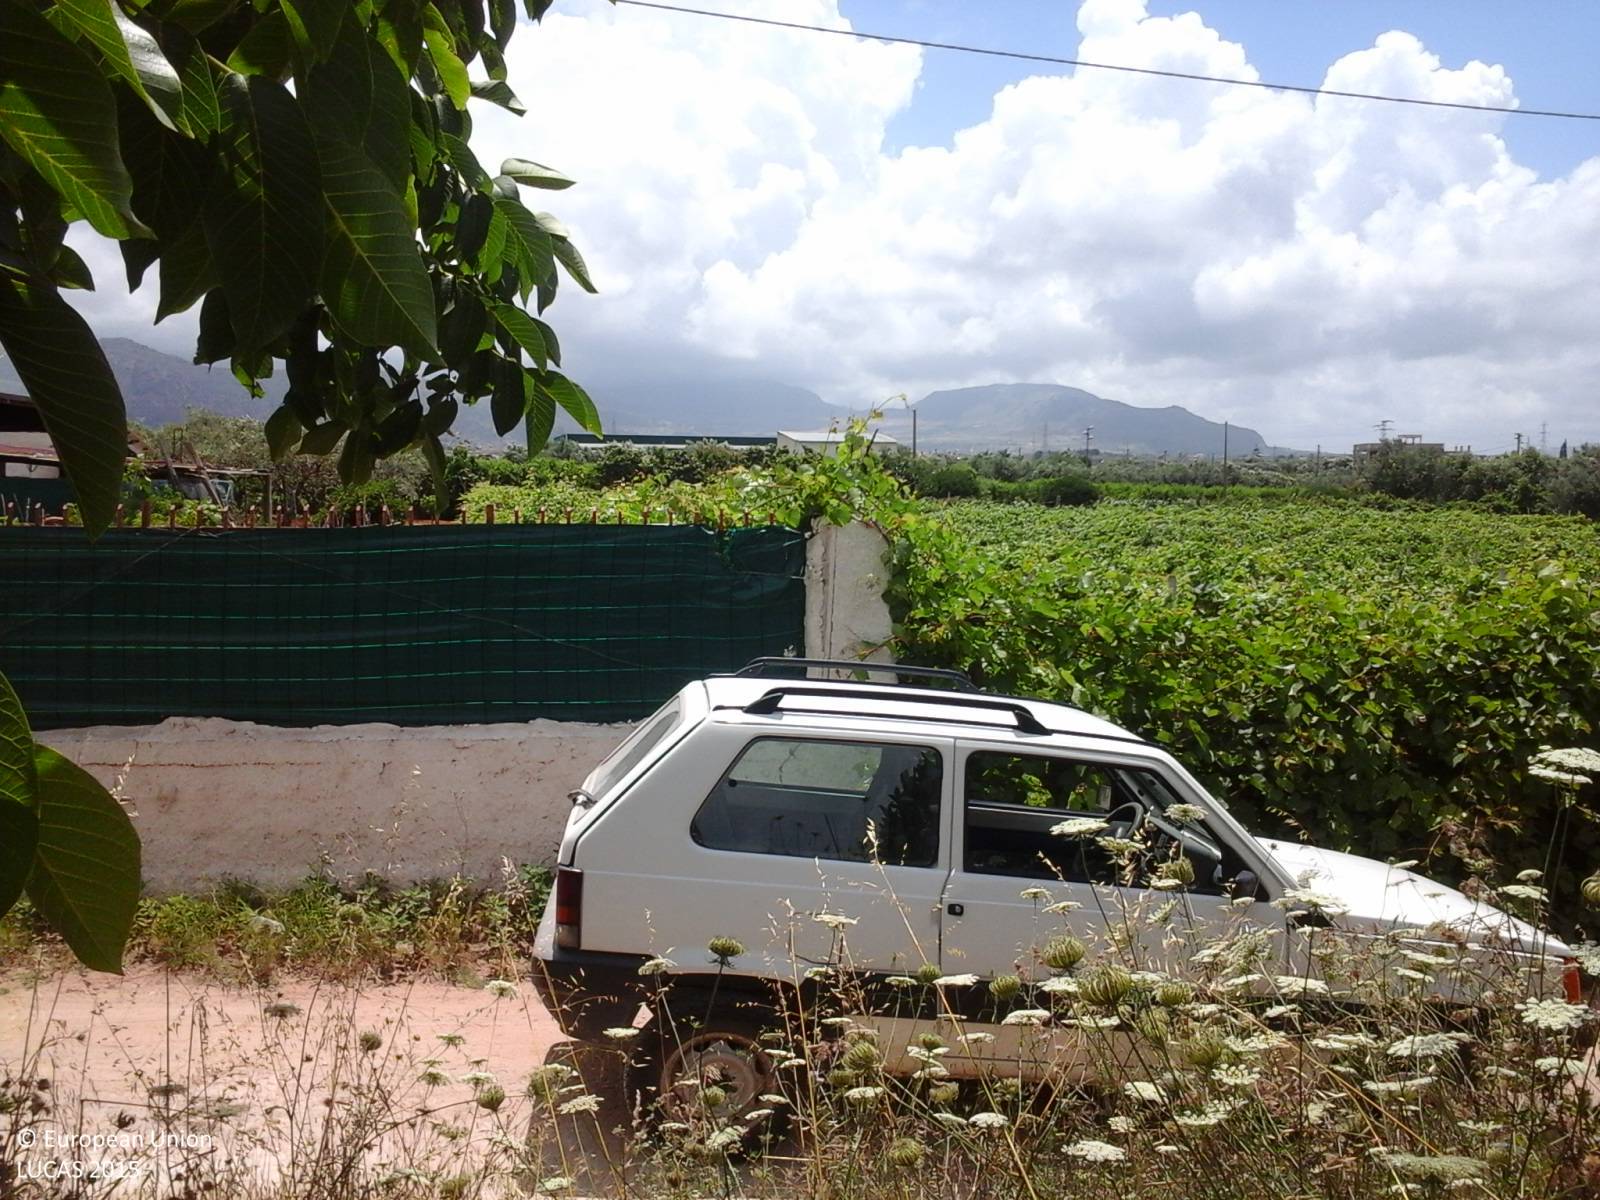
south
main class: Grassland
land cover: Grassland with sparse tree/shrub cover
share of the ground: > 75 %
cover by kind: herbaceous plants 85 %, shrubs 10 %, broadleaved forest trees 5 %
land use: Abandoned areas
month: June
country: IT
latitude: 38.0606
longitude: 13.0895
